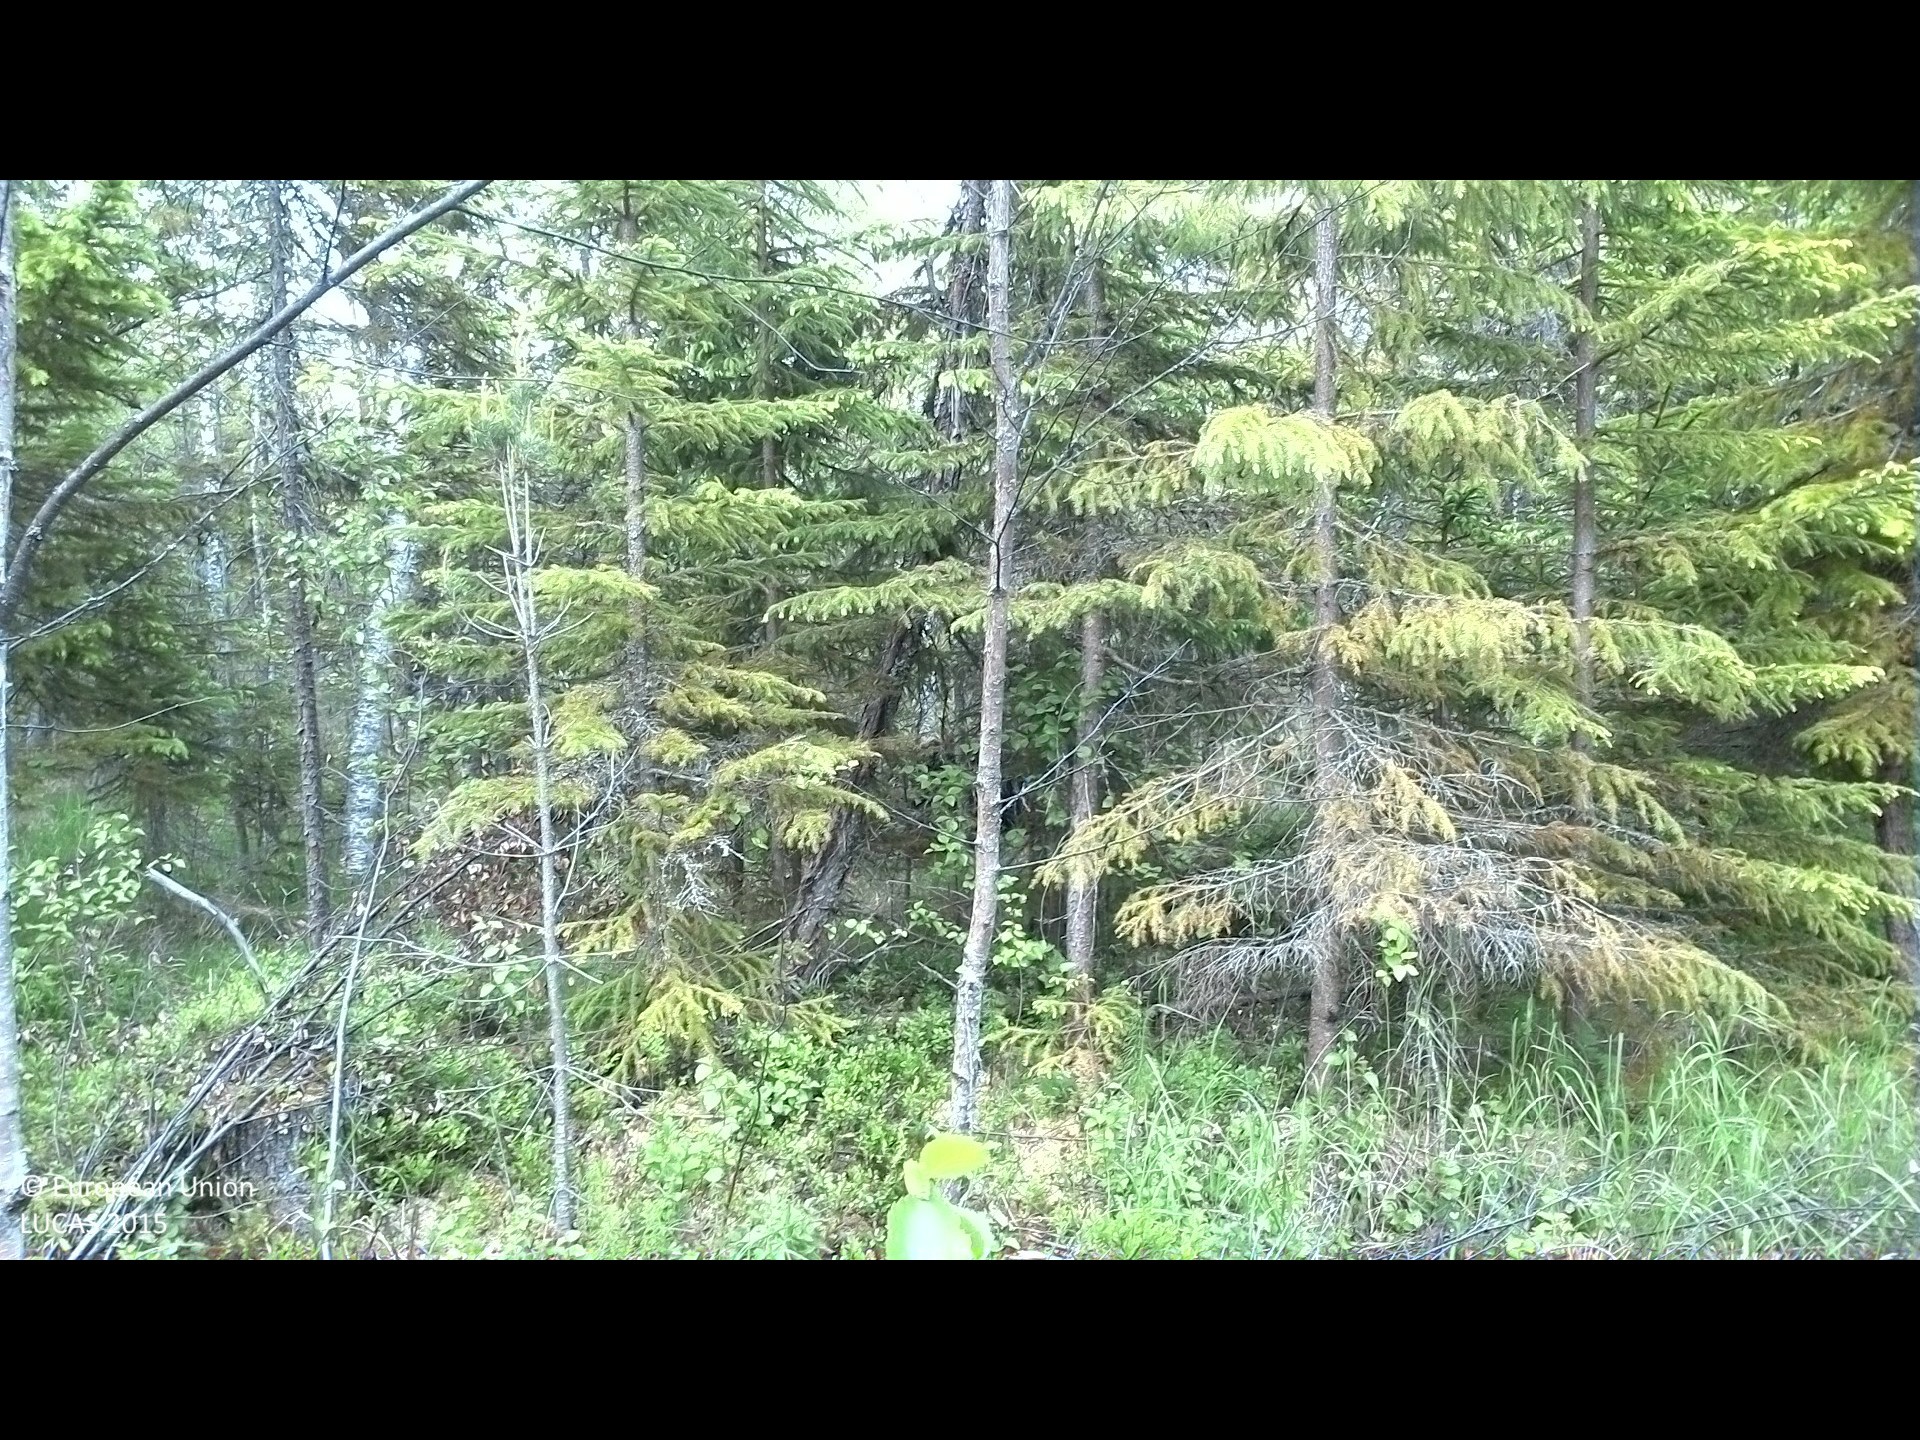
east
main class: Woodland
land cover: Spruce dominated mixed woodland
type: boreal forest
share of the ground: 25 - 50 %
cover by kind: lichens and mosses 40 %, shrubs 25 %, coniferous forest trees 15 %, broadleaved forest trees 10 %, herbaceous plants 10 %
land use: Forestry
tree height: > 5 m
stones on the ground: < 10 %
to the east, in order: Spruce dominated mixed woodland; Pine dominated mixed woodland; Pine dominated coniferous woodland
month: June
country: SE
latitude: 62.2051
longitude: 17.1900
